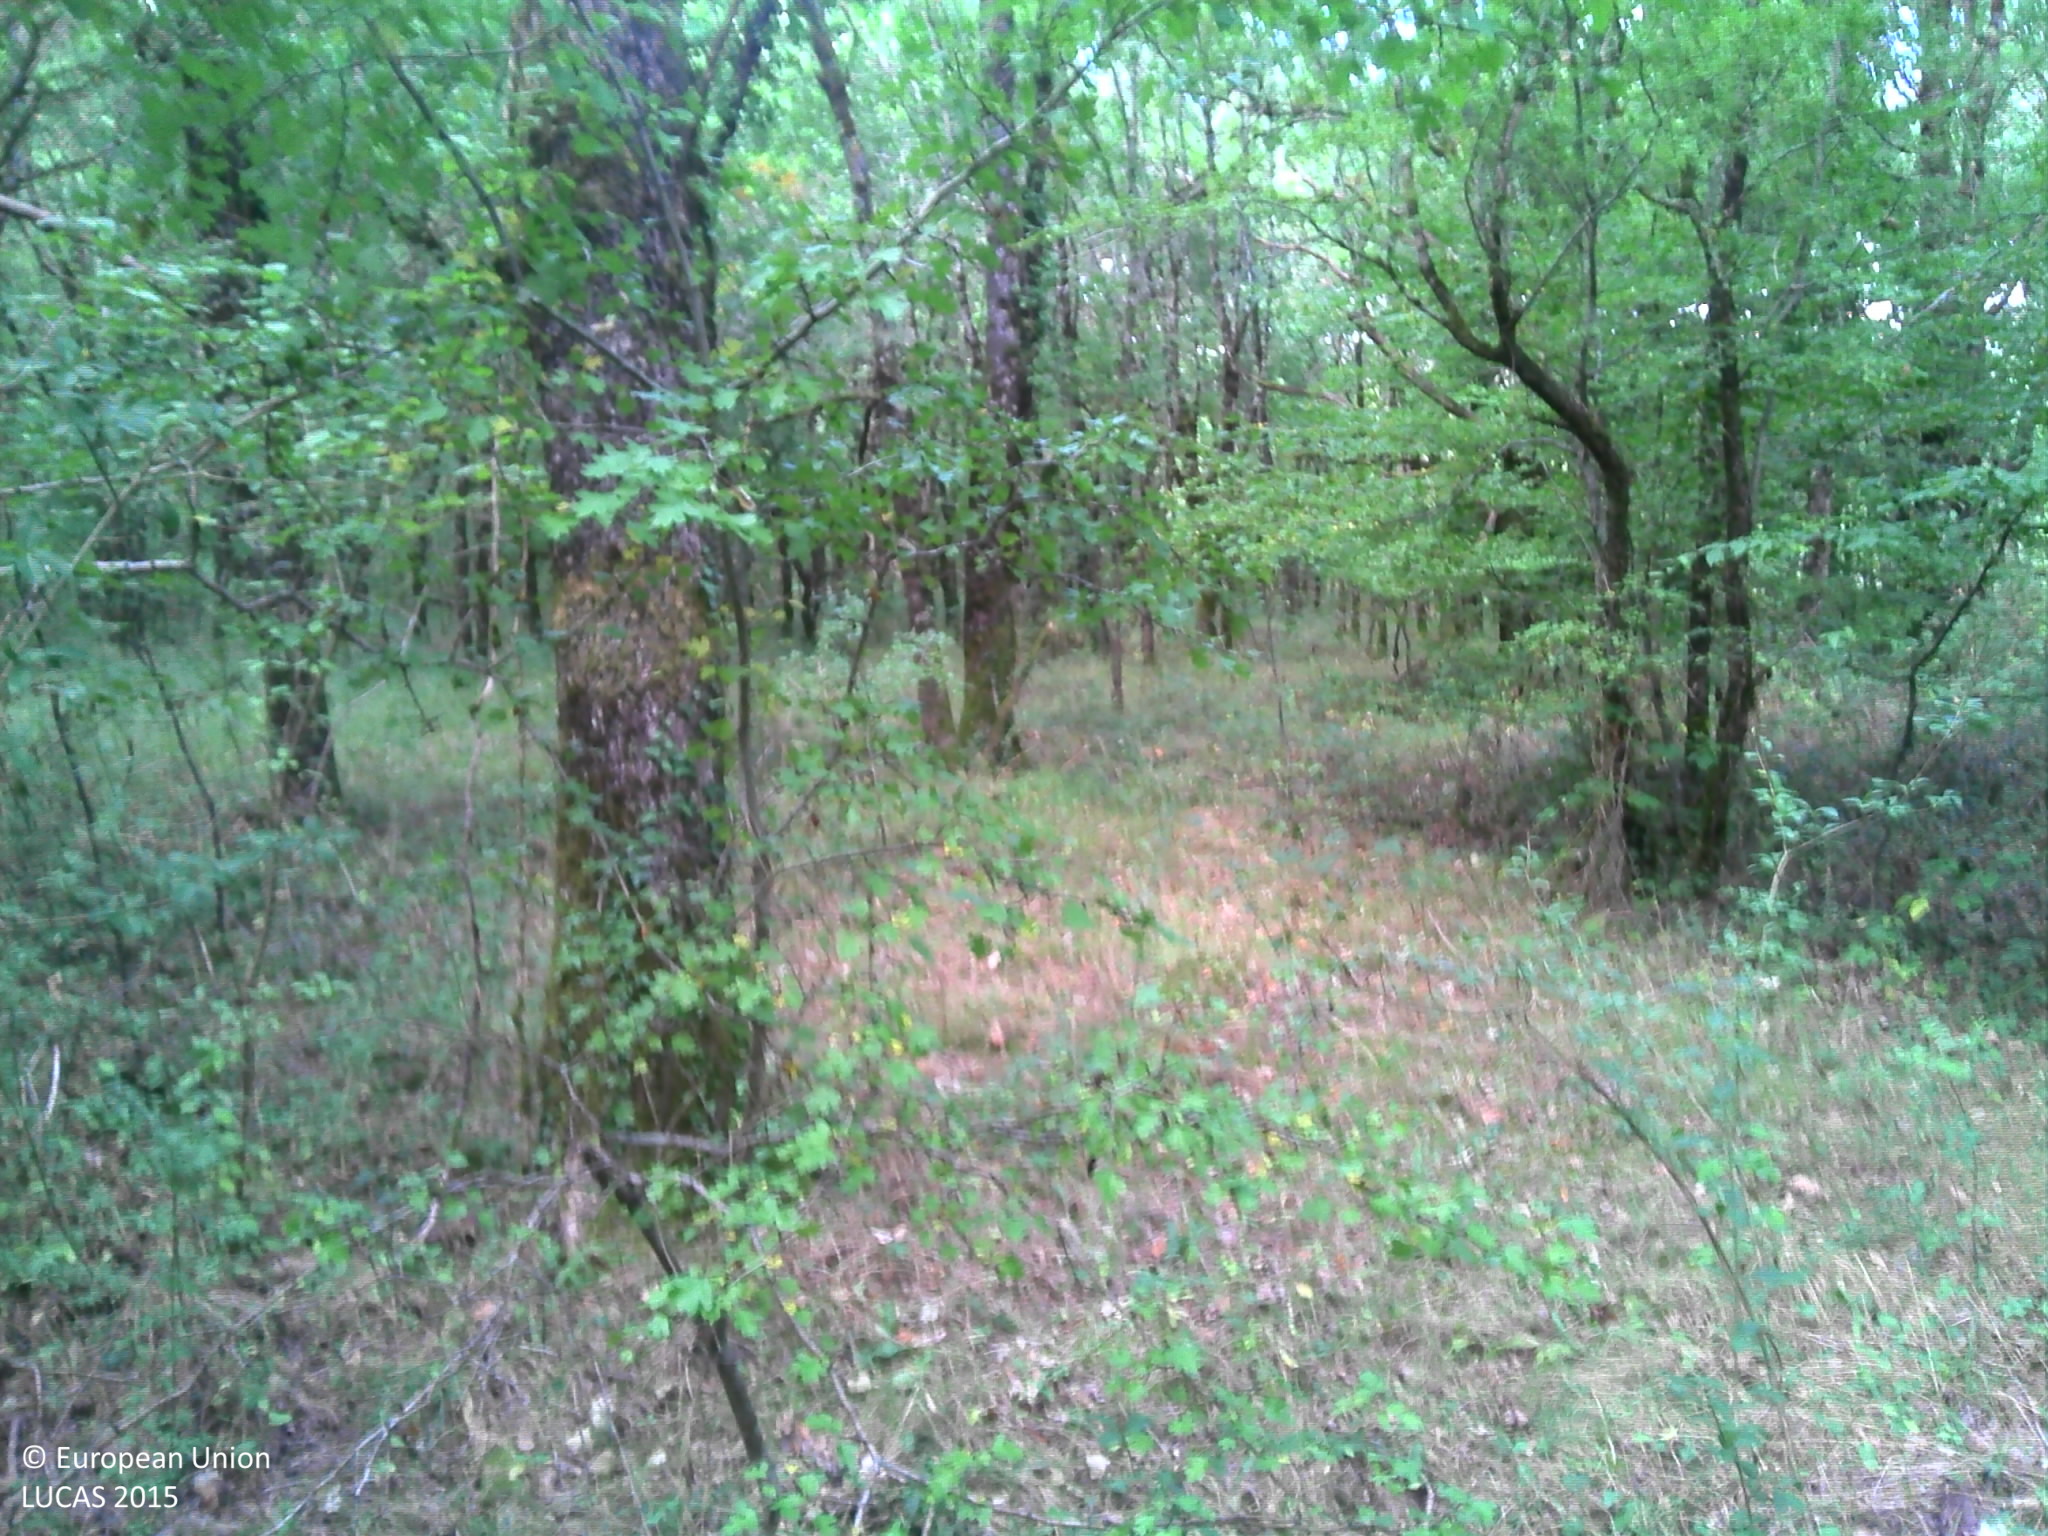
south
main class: Woodland
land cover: Broadleaved woodland
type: mesophytic deciduous forest
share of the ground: > 75 %
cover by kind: broadleaved forest trees 85 %, shrubs 10 %, herbaceous plants 5 %
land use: Forestry
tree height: > 5 m
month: July
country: FR
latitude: 46.7520
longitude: 1.4664
